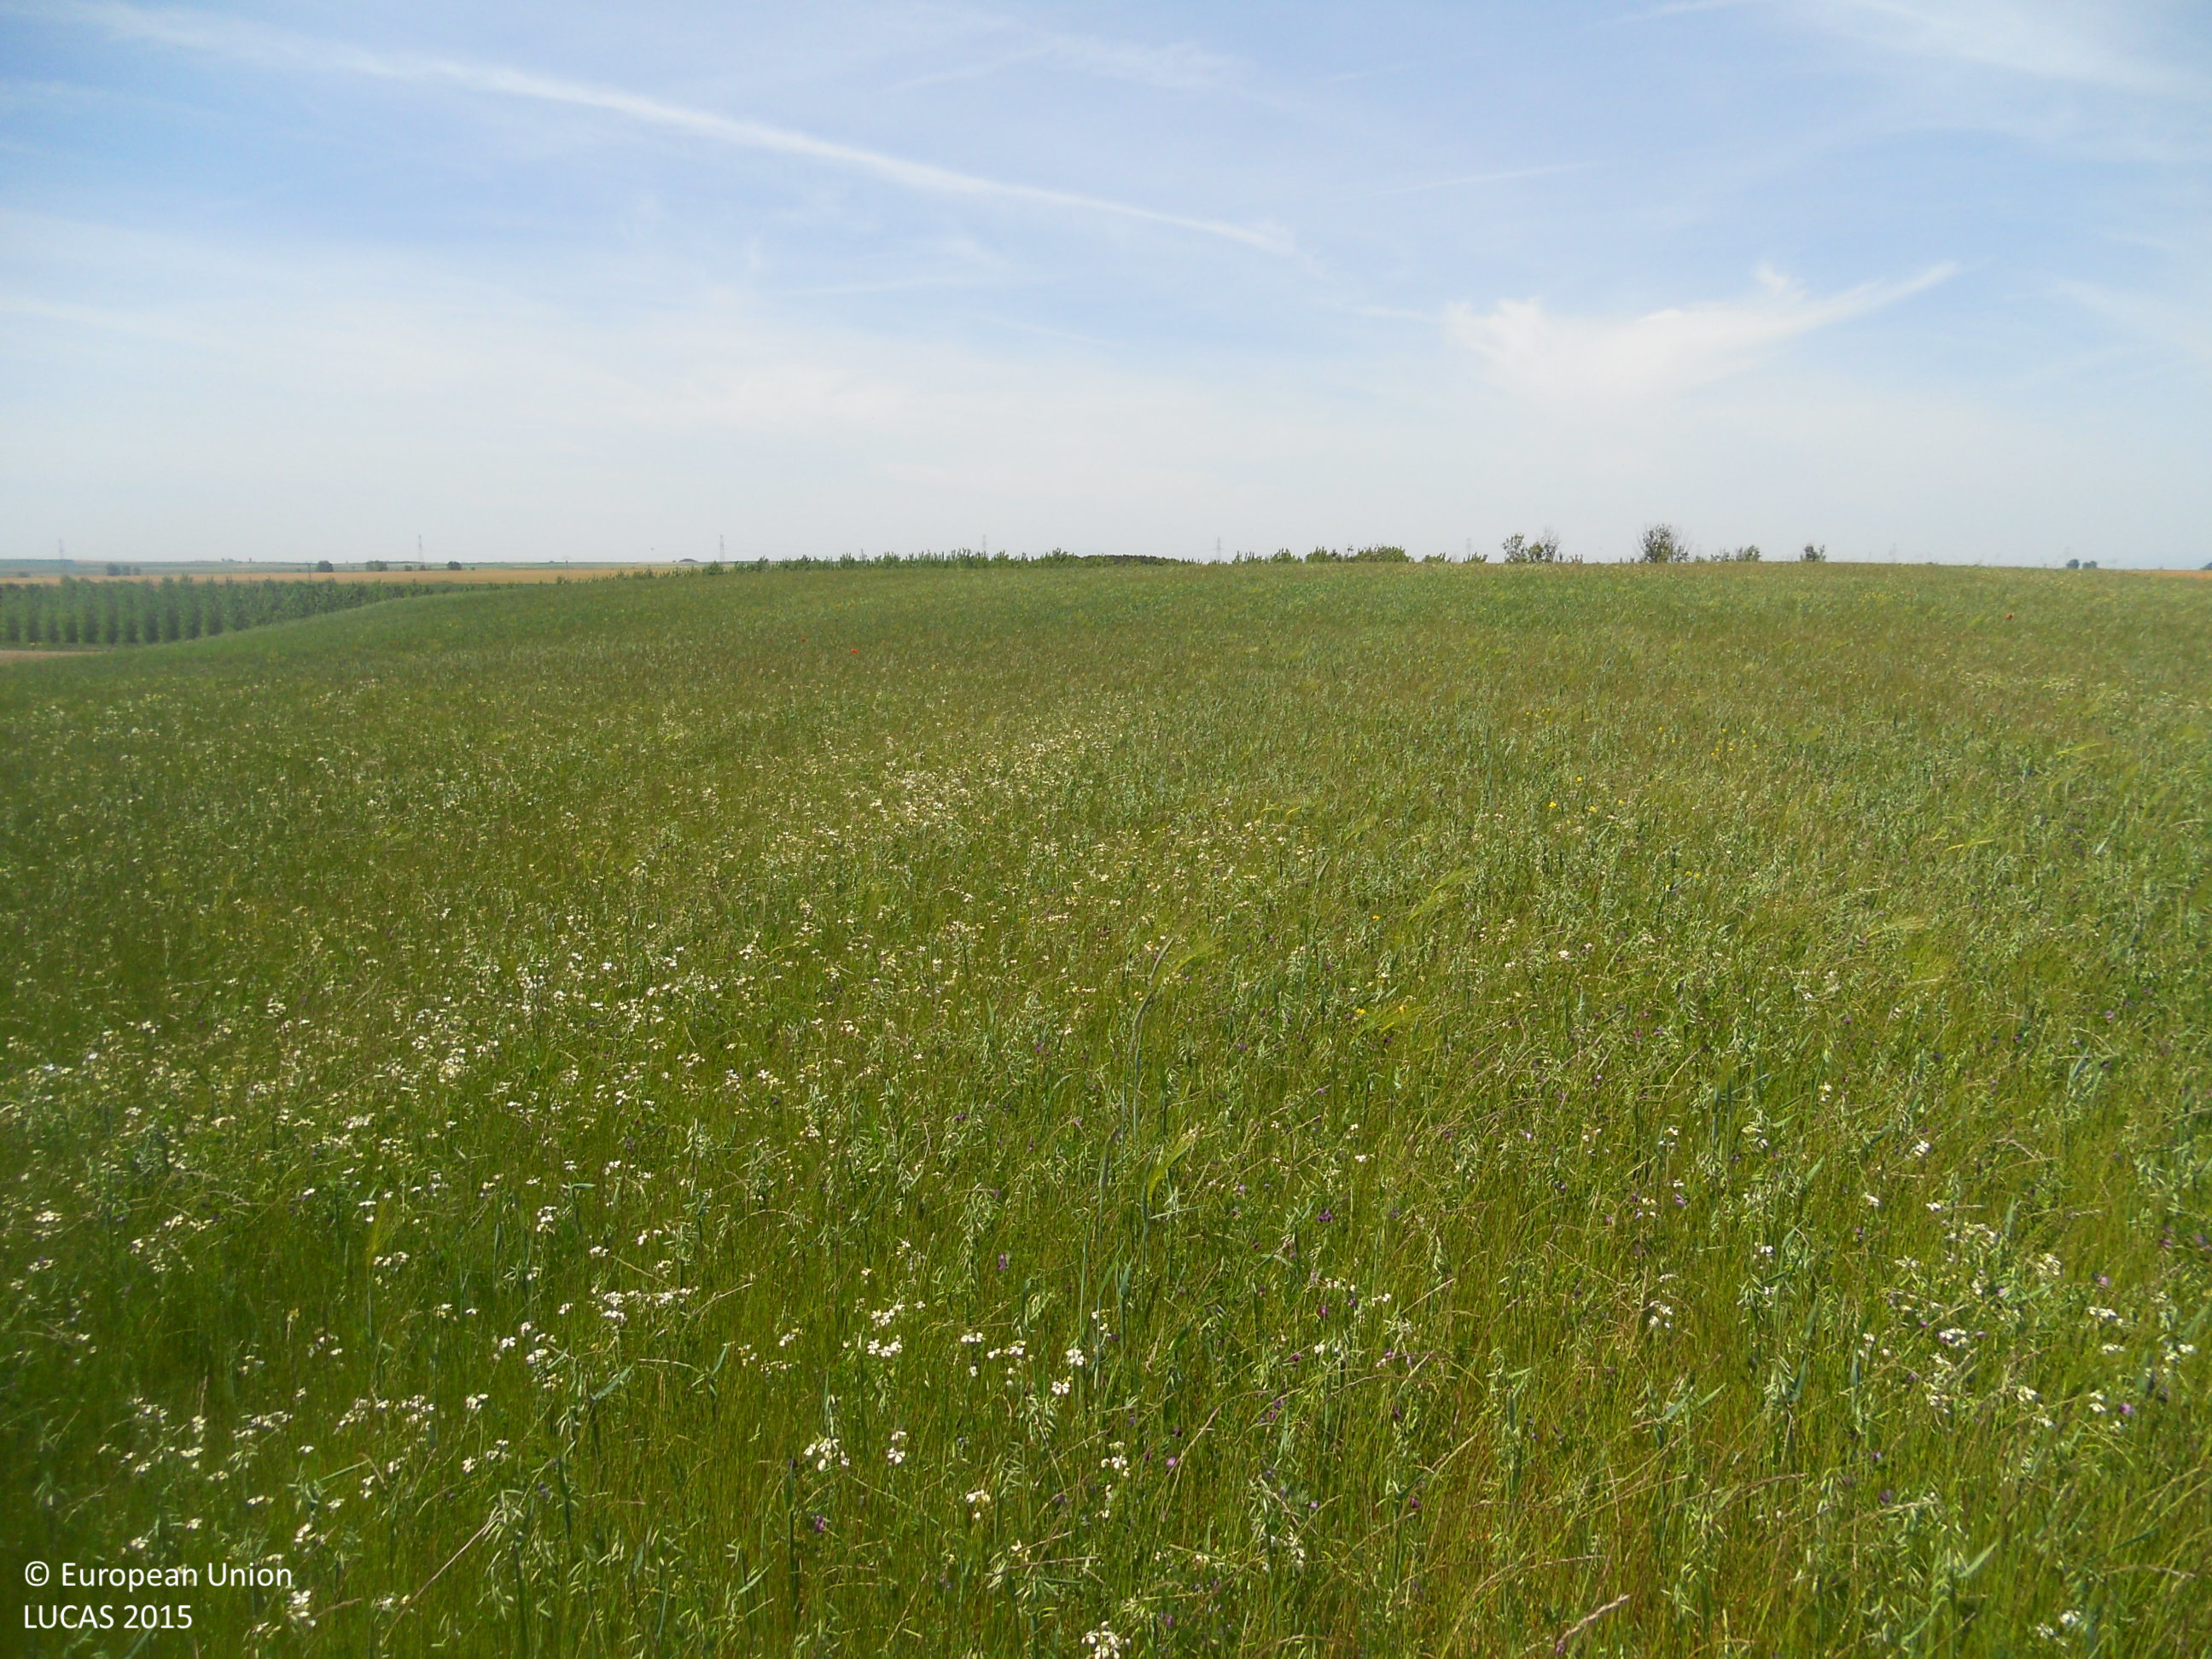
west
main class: Cropland
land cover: Mixed cereals for fodder
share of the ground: > 75 %
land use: Agriculture (excluding fallow land and kitchen gardens)
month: May
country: ES
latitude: 42.3815
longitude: -5.3076
